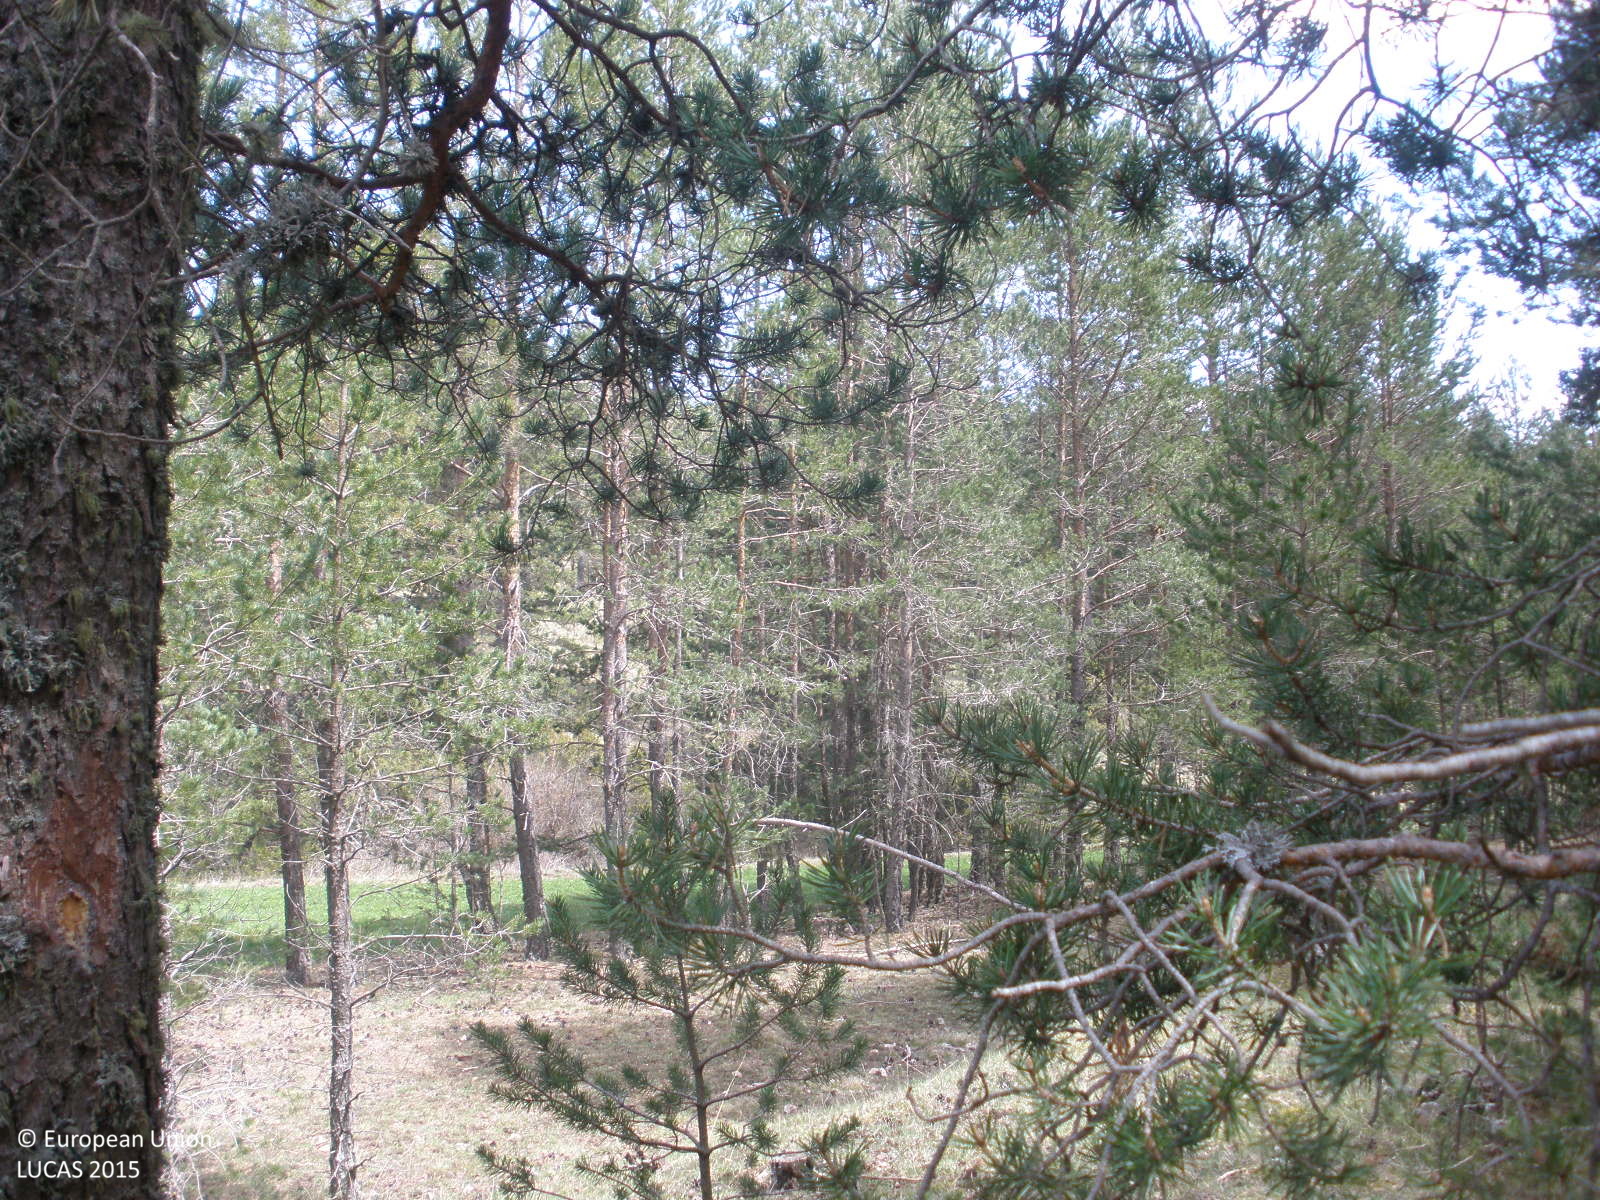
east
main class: Woodland
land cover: Pine dominated coniferous woodland
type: coniferous forest of the mediterranean region
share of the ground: > 75 %
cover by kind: coniferous forest trees 70 %, herbaceous plants 30 %
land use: Semi-natural and natural areas not in use
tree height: > 5 m
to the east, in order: Pine dominated coniferous woodland; Lucerne; Rivers and streams; Pine dominated coniferous woodland; Tracks; Pine dominated coniferous woodland
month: April
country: ES
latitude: 40.4050
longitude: -0.7433
